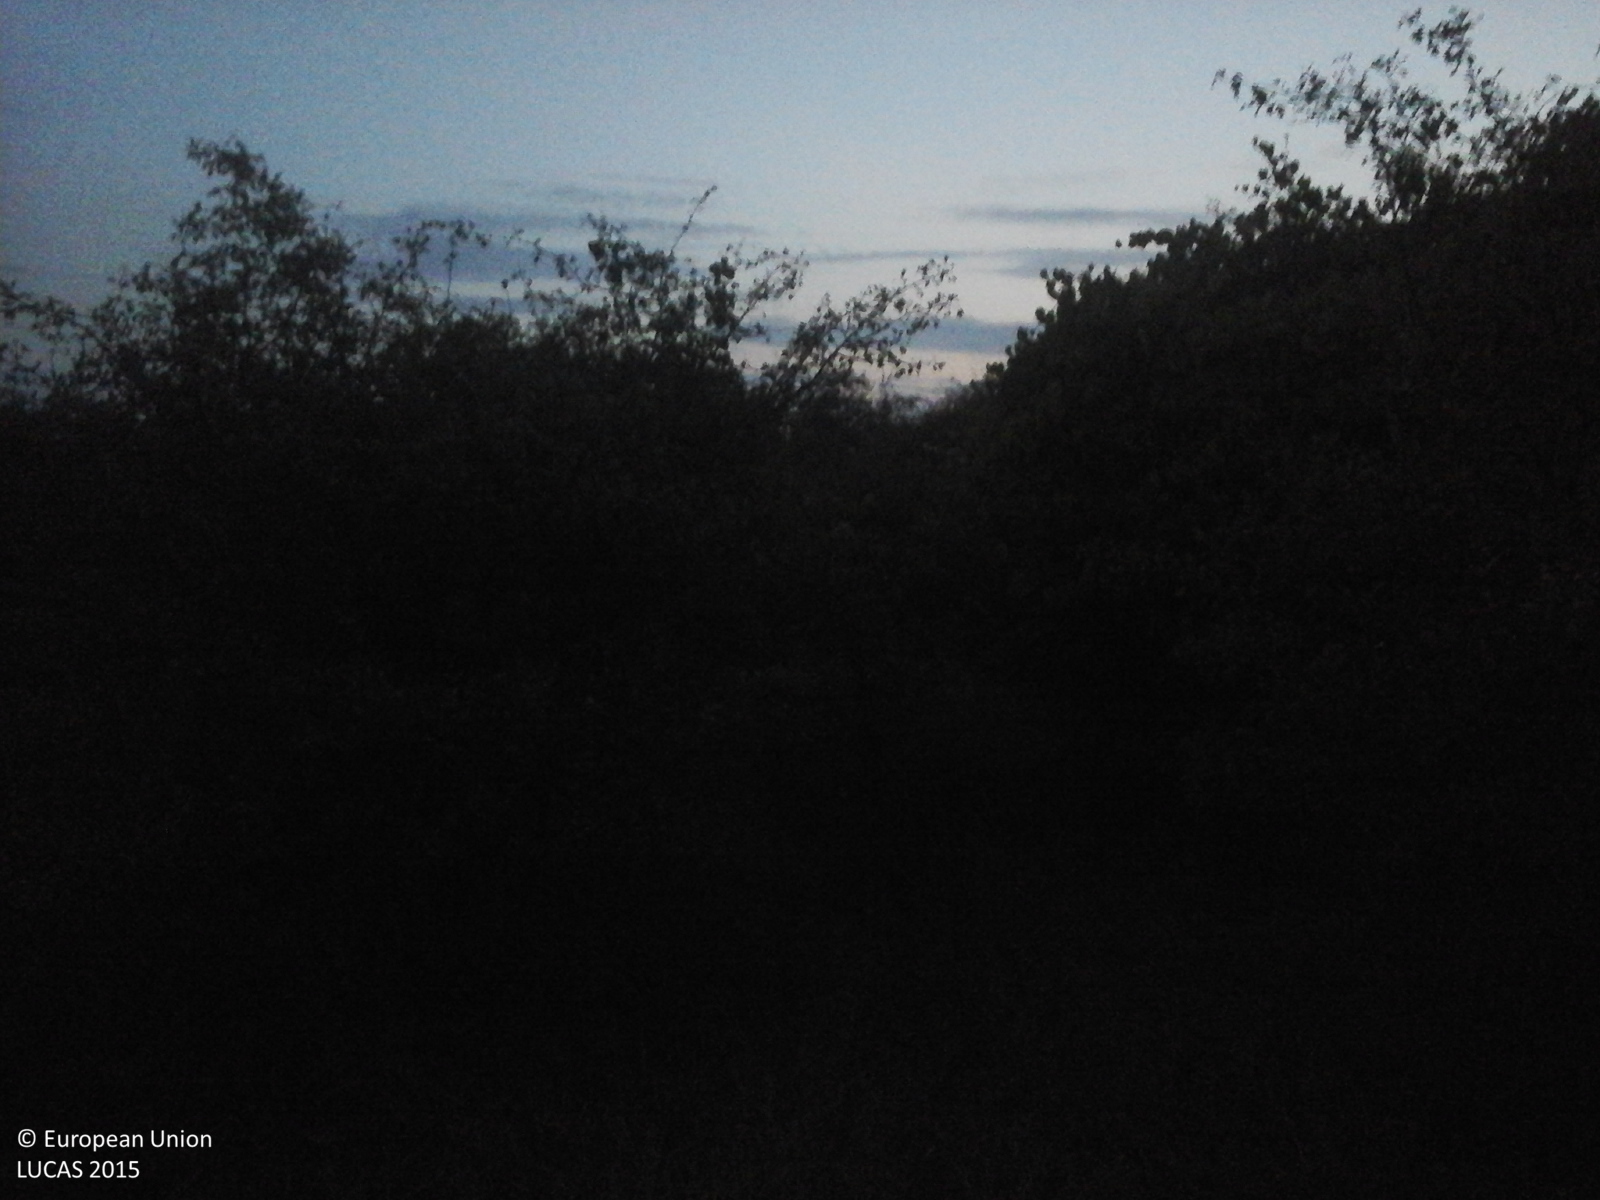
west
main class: Cropland
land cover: Vineyards
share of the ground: > 75 %
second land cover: Shrubland without tree cover
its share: > 75 %
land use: Abandoned areas
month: August
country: RO
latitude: 44.3239
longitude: 28.0251
